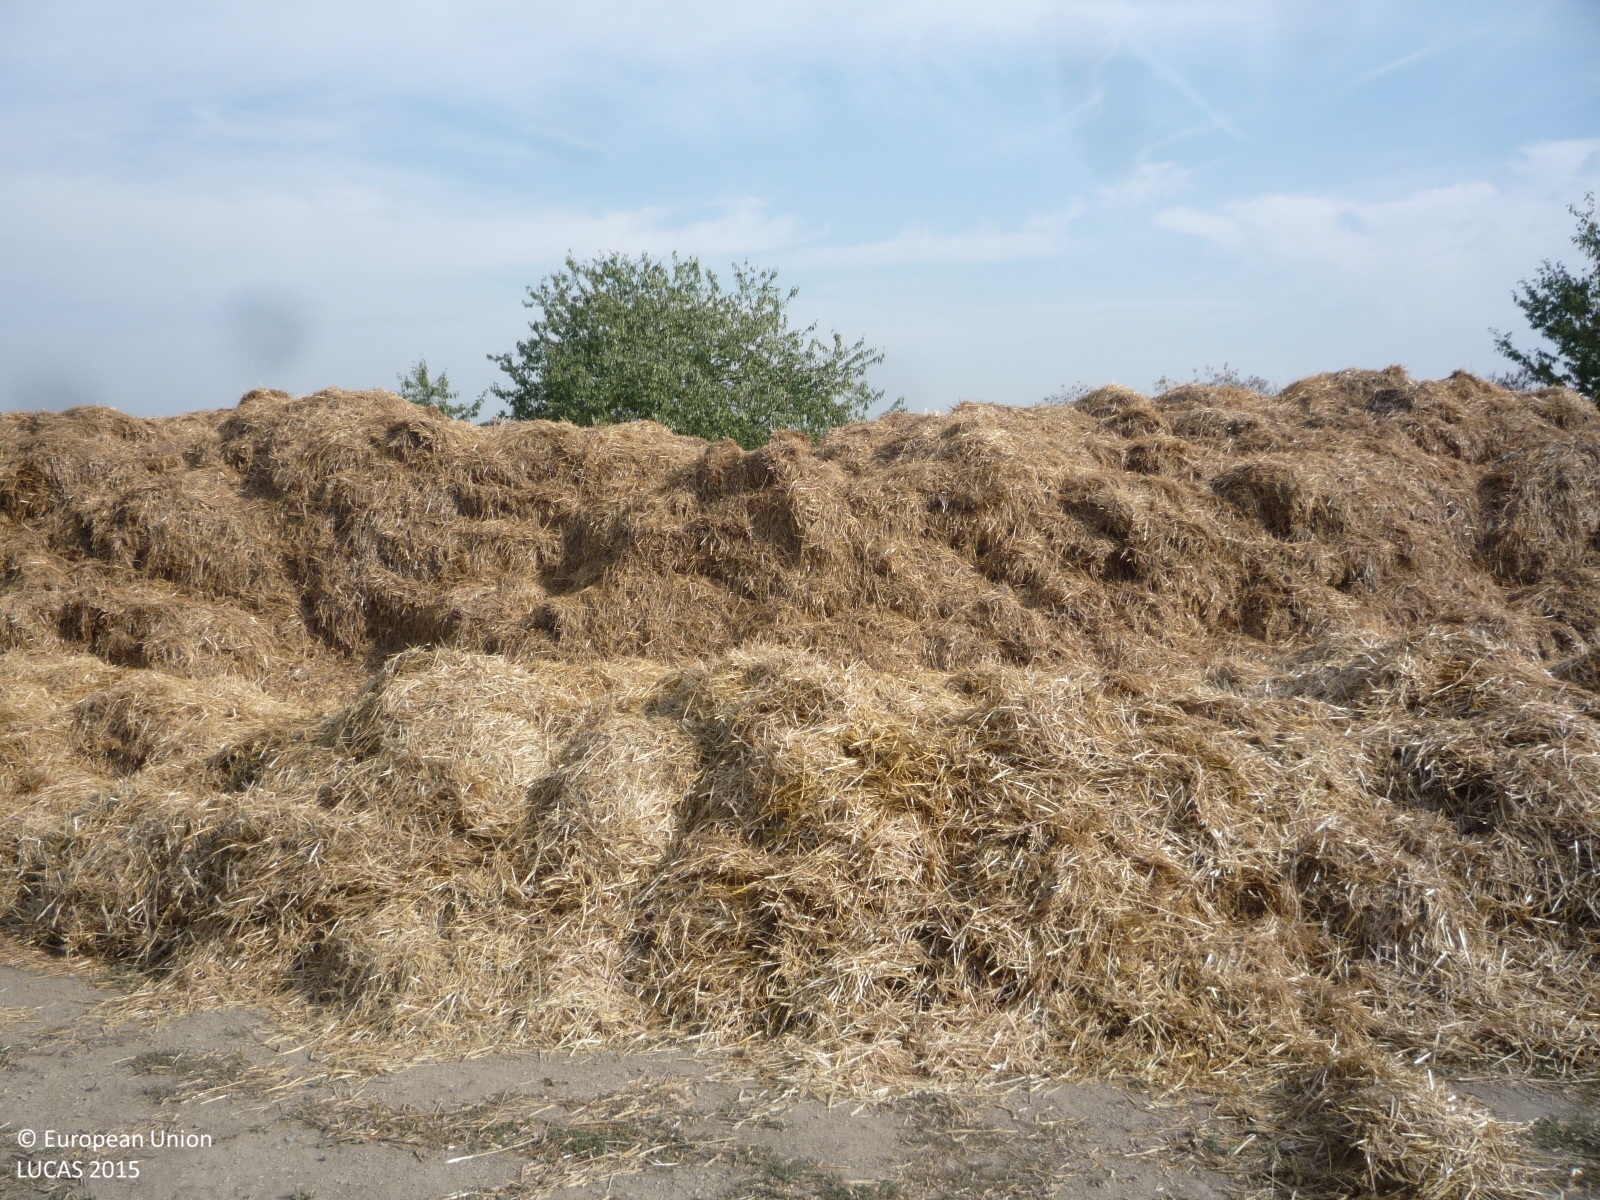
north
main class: Grassland
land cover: Grassland without tree/shrub cover
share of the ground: > 75 %
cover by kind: herbaceous plants 90 %, unconsolidated bare surface 10 %
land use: Agriculture (excluding fallow land and kitchen gardens)
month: August
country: CZ
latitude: 49.9545
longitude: 14.4198
